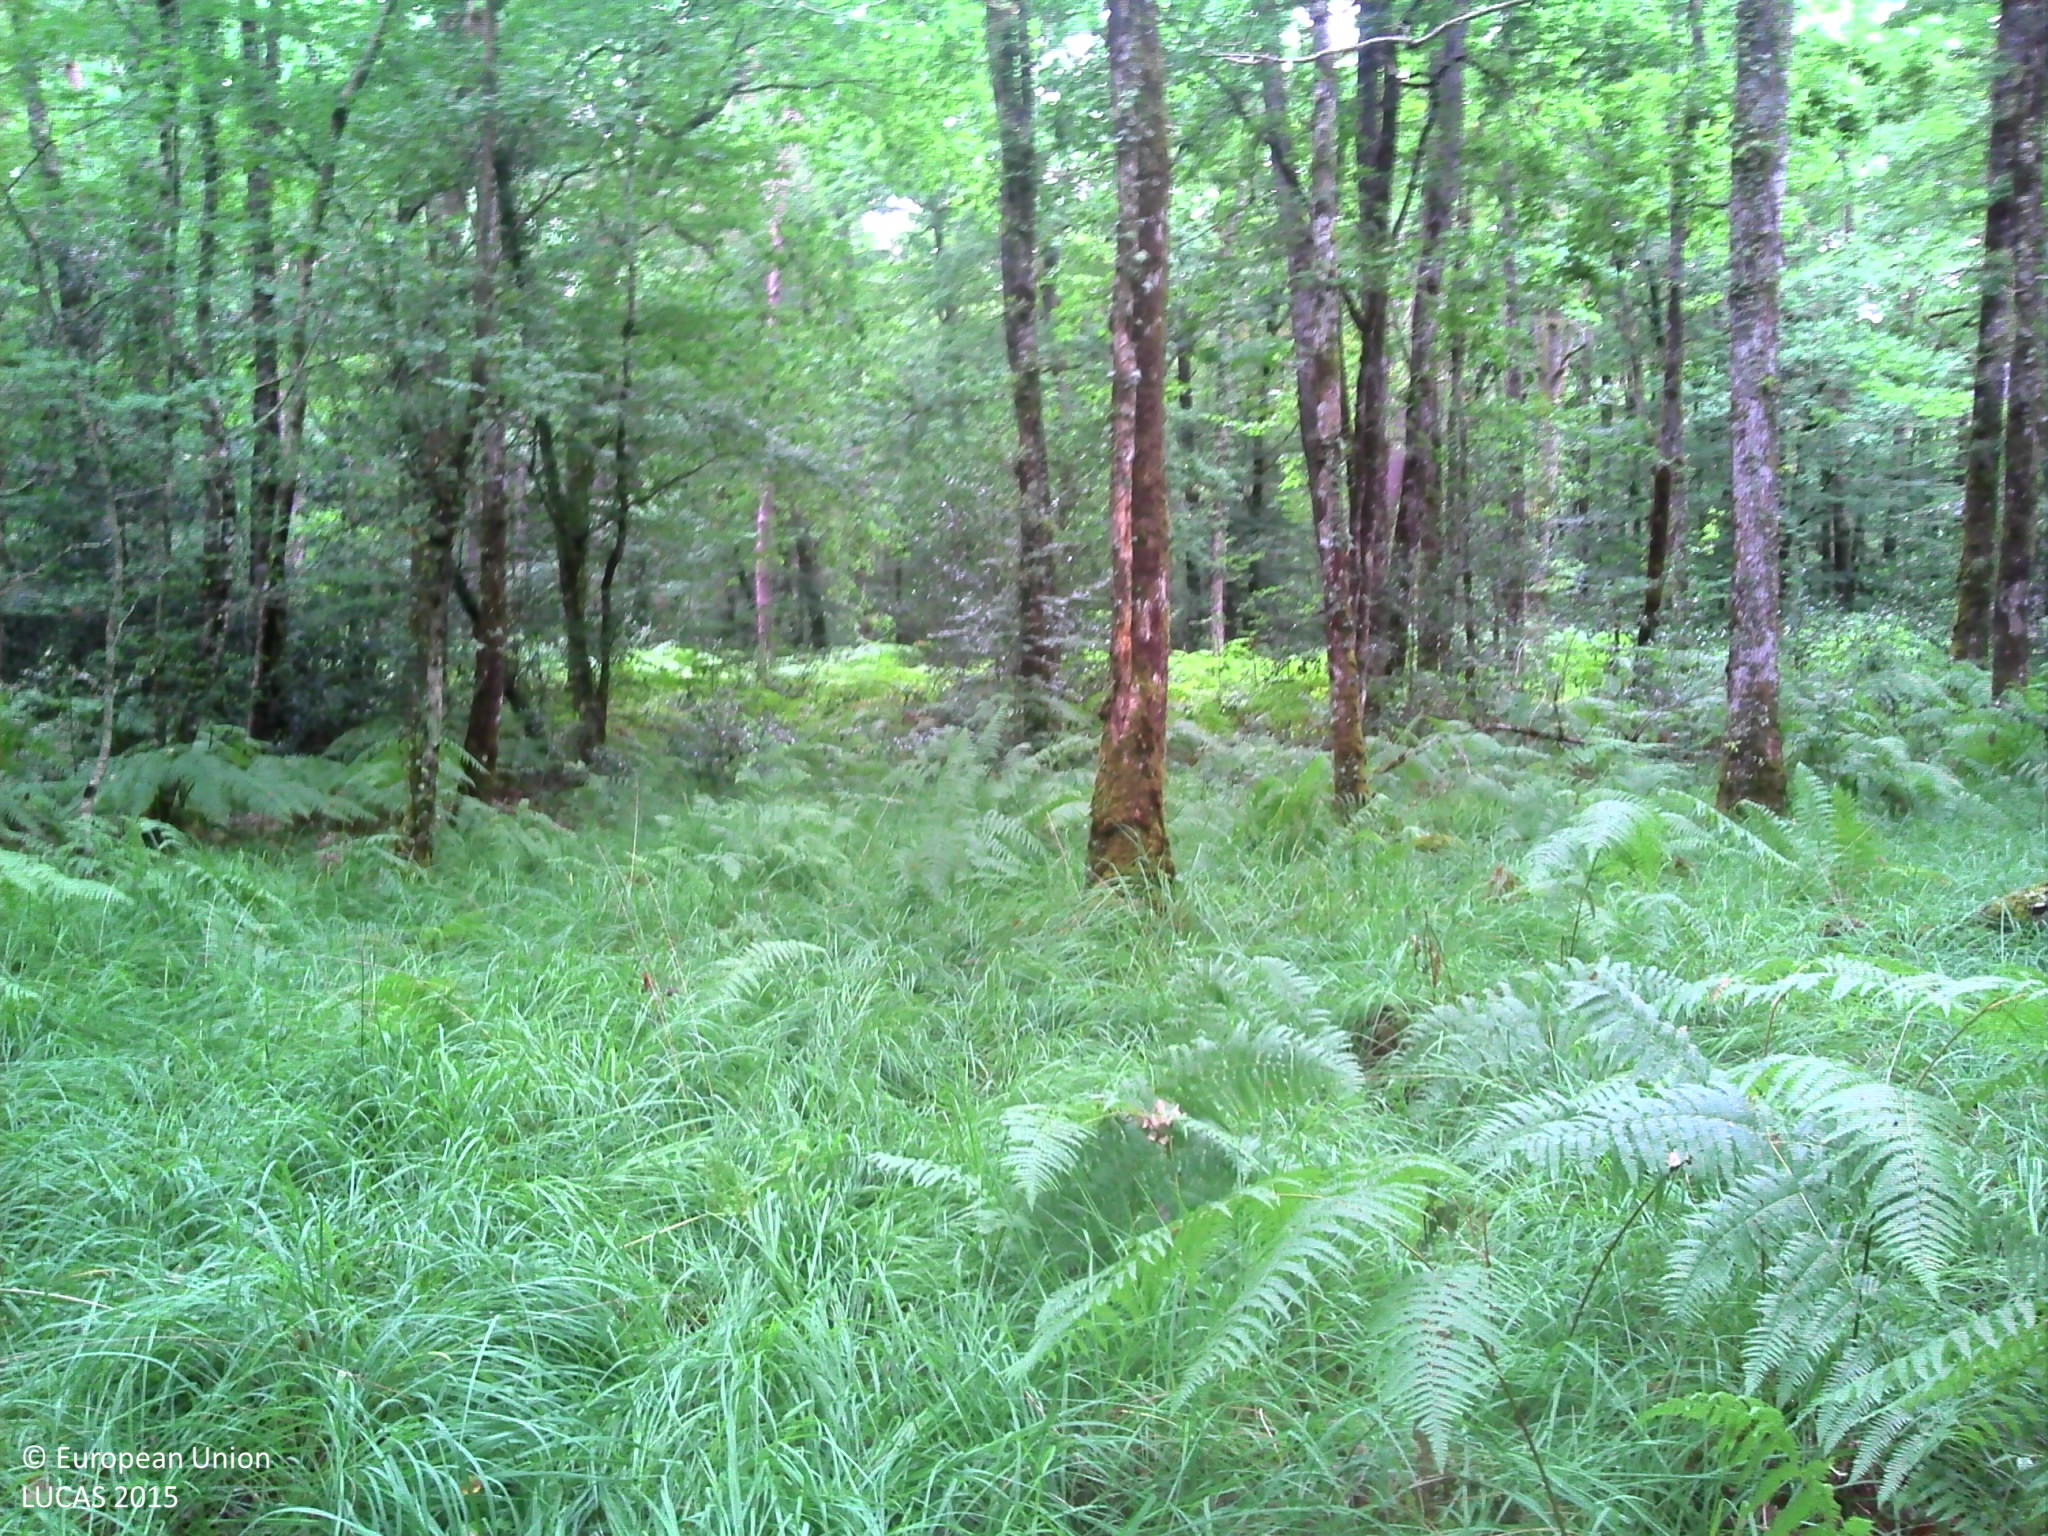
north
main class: Woodland
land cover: Broadleaved woodland
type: acidophilous oak and oak-birch forest
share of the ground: > 75 %
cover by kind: broadleaved forest trees 90 %, coniferous forest trees 5 %, herbaceous plants 5 %
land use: Forestry
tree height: > 5 m
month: July
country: FR
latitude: 47.5324
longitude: -1.8028
